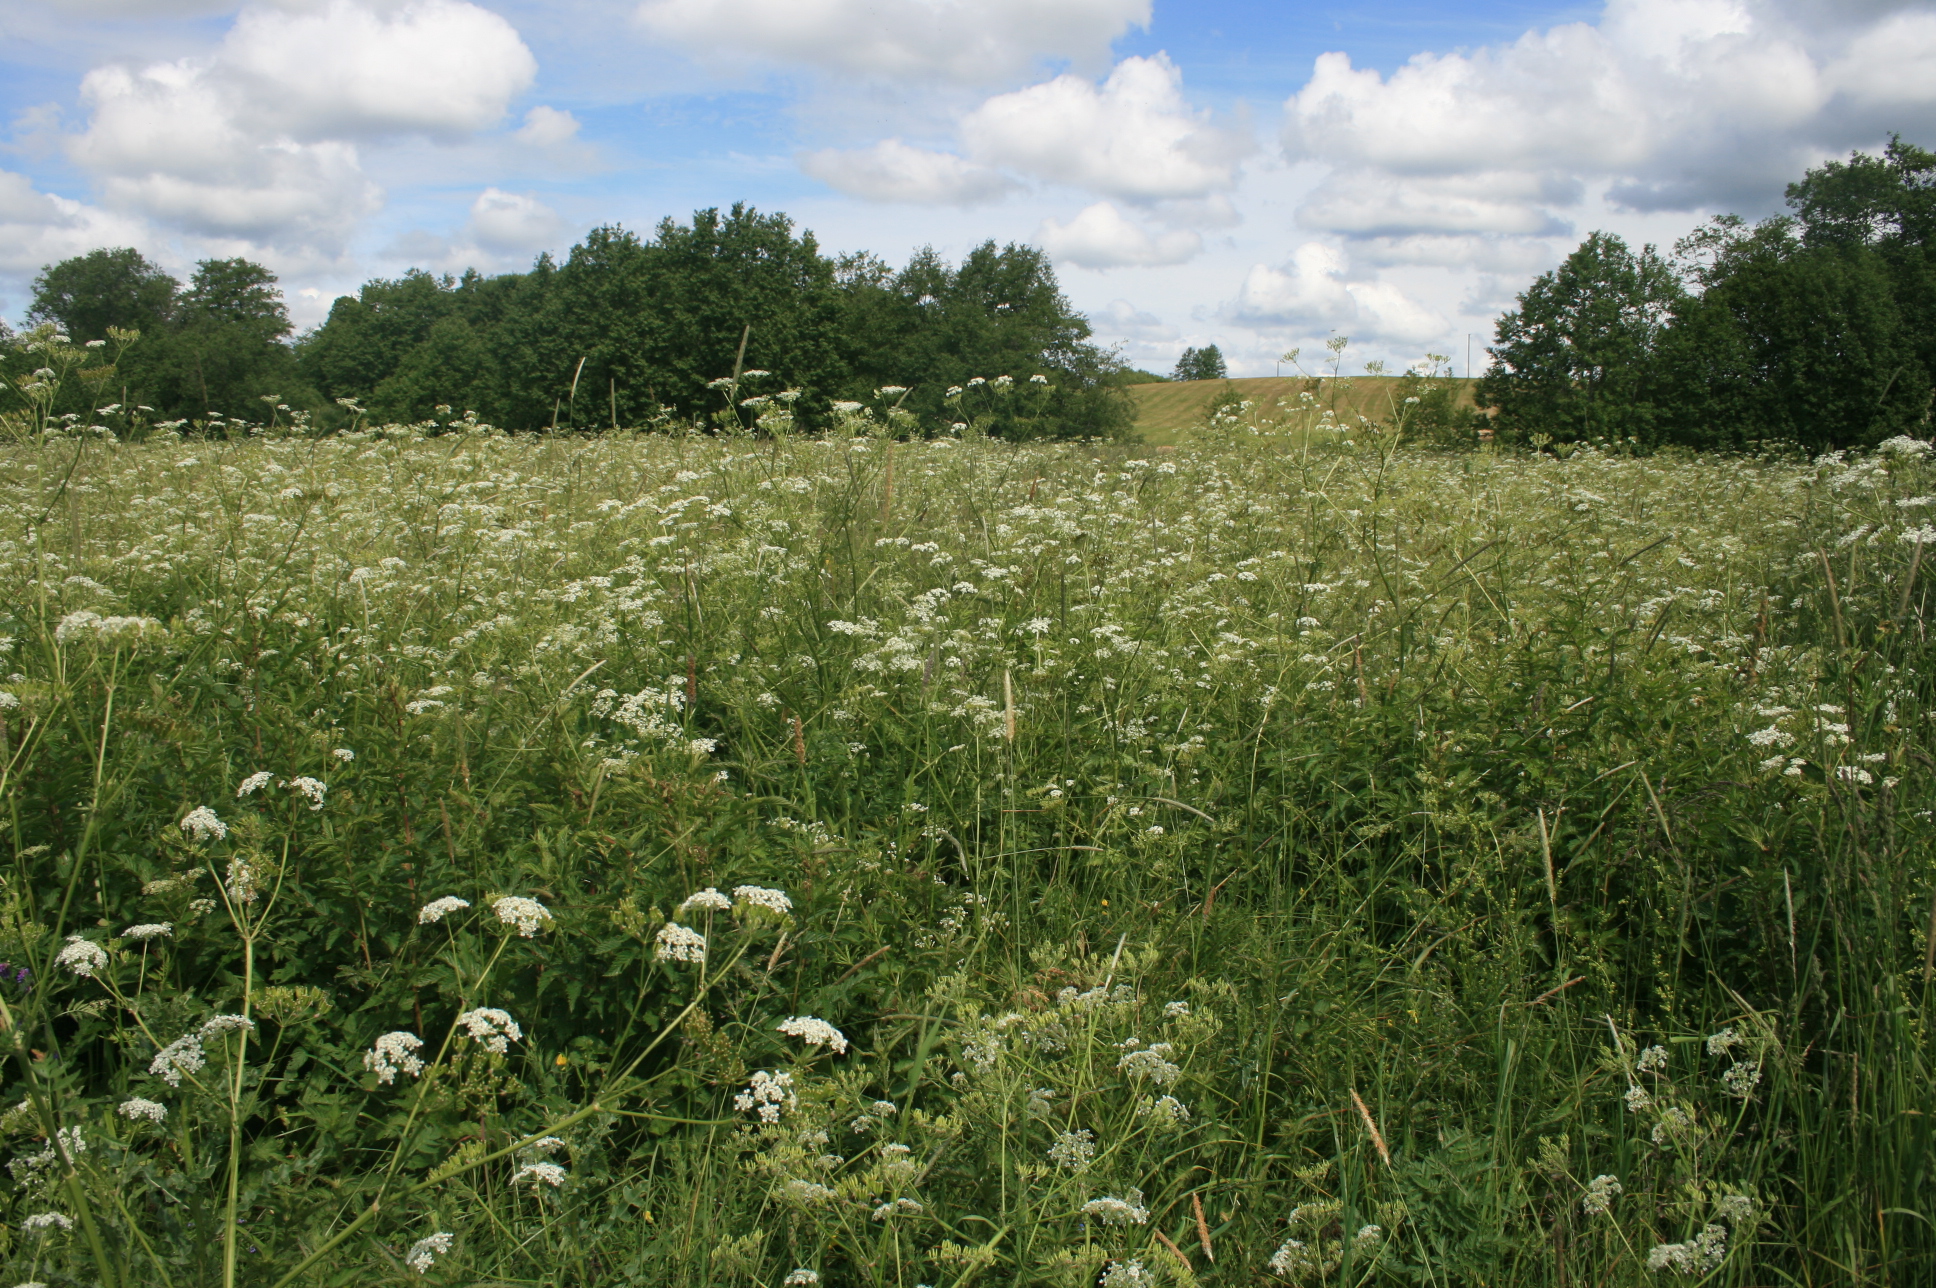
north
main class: Grassland
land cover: Spontaneously vegetated surfaces
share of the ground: > 75 %
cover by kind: herbaceous plants 100 %
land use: Fallow land
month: June
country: LT
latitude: 55.2643
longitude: 22.1258
